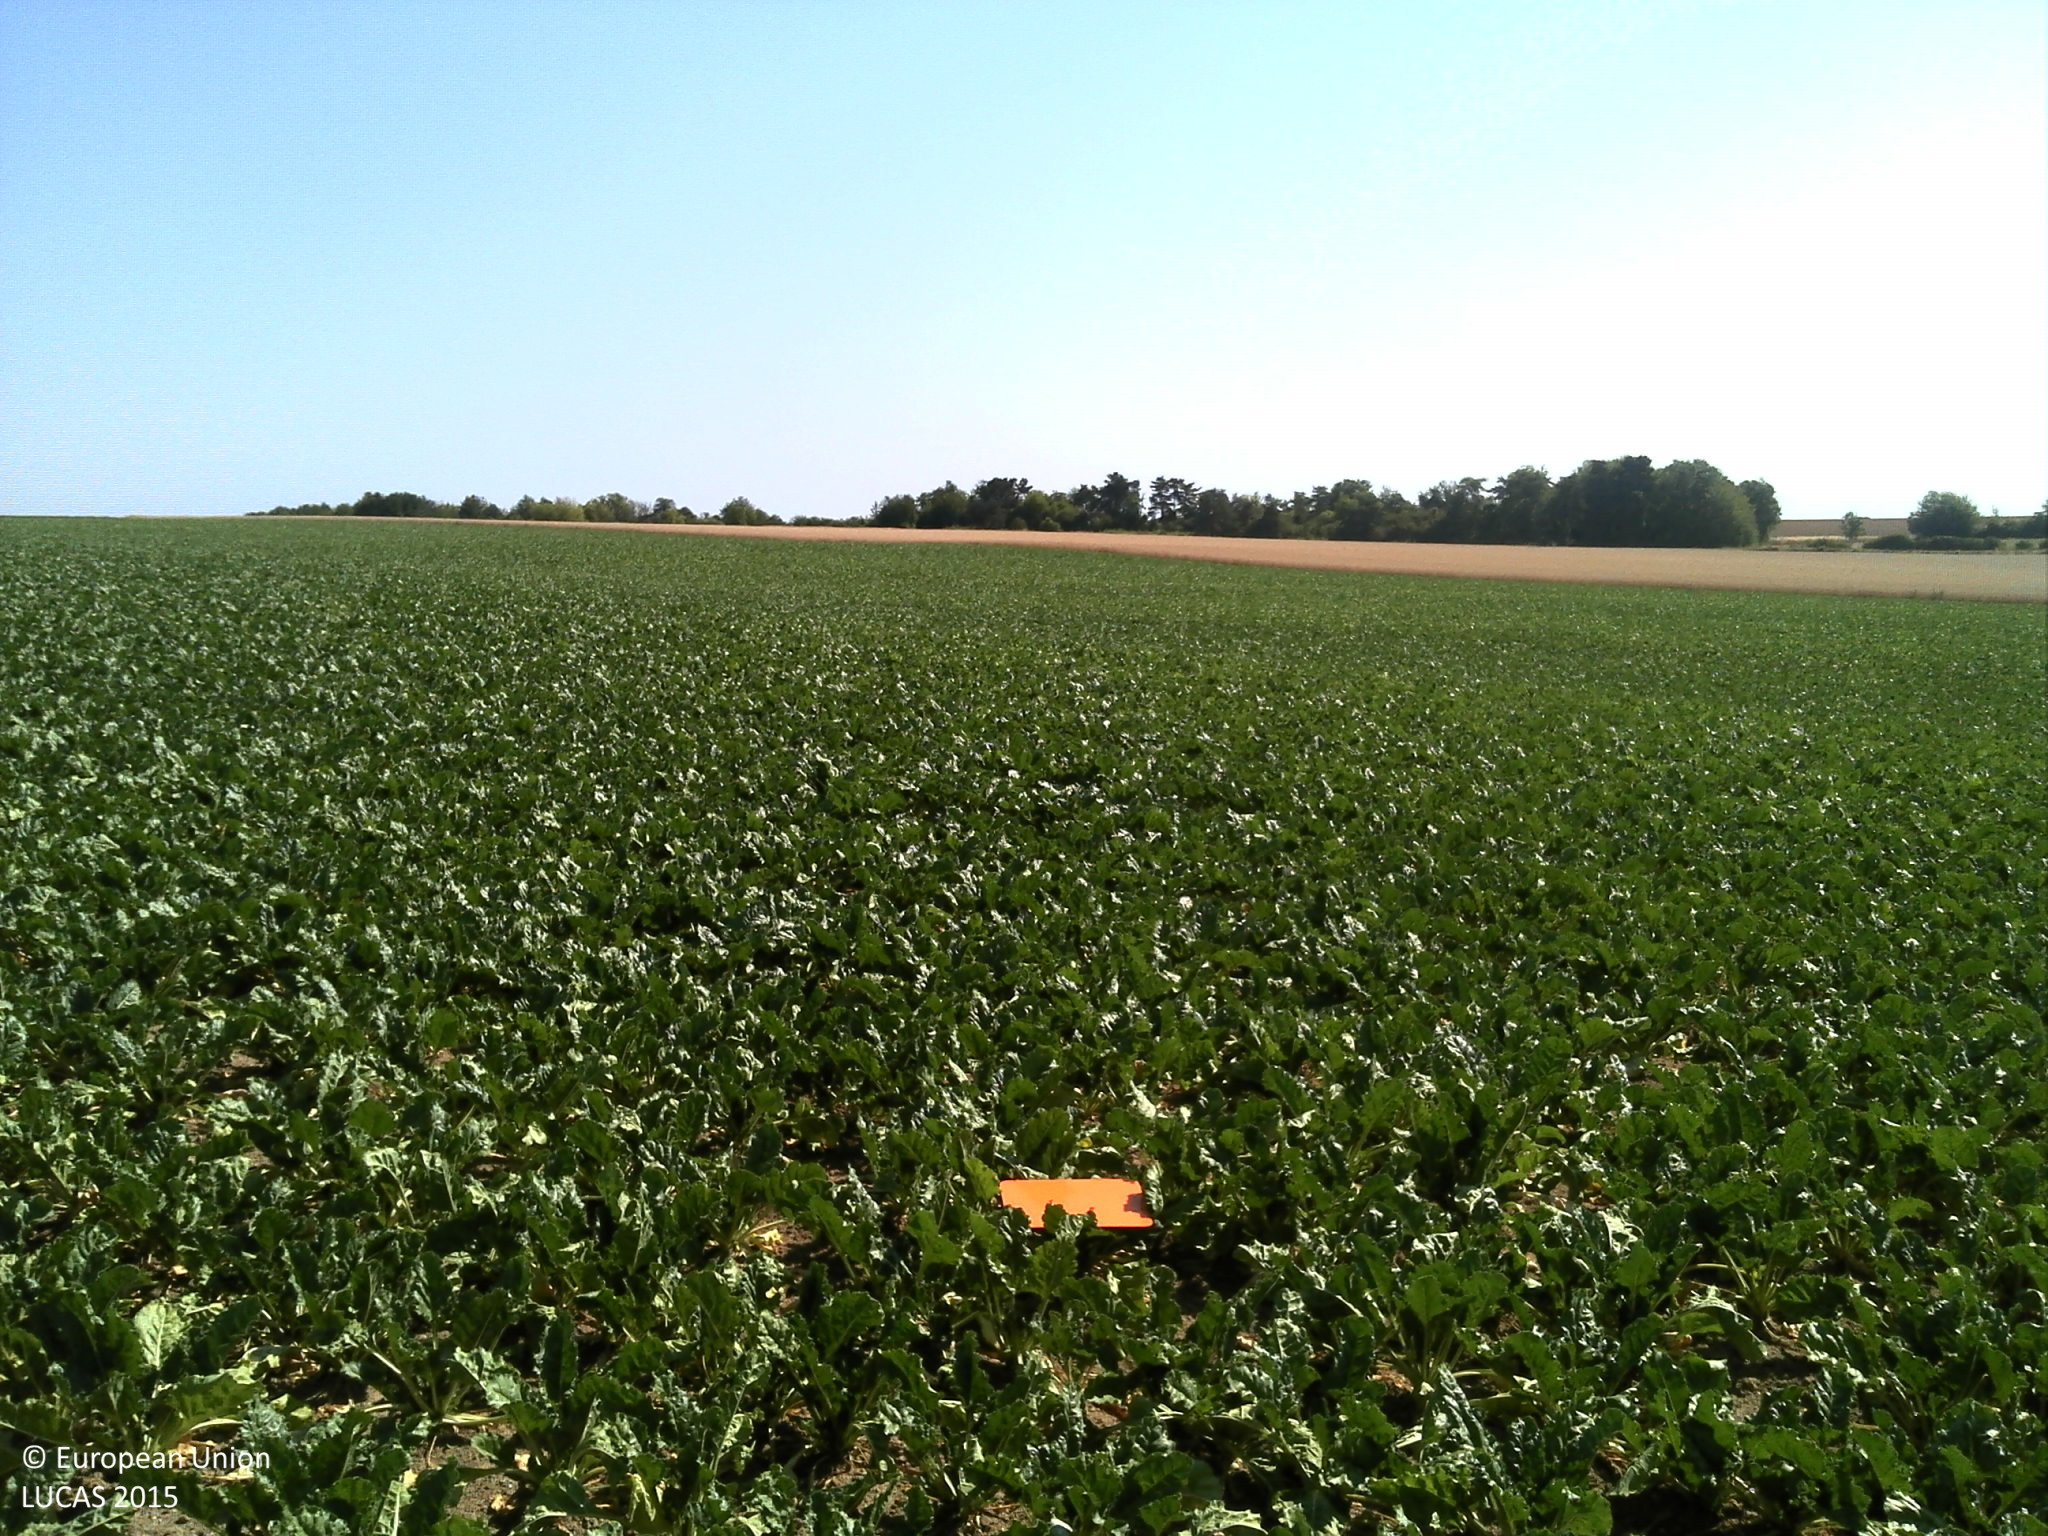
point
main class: Cropland
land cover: Sugar beet
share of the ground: > 75 %
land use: Agriculture (excluding fallow land and kitchen gardens)
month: July
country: FR
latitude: 49.4368
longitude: 4.1067
